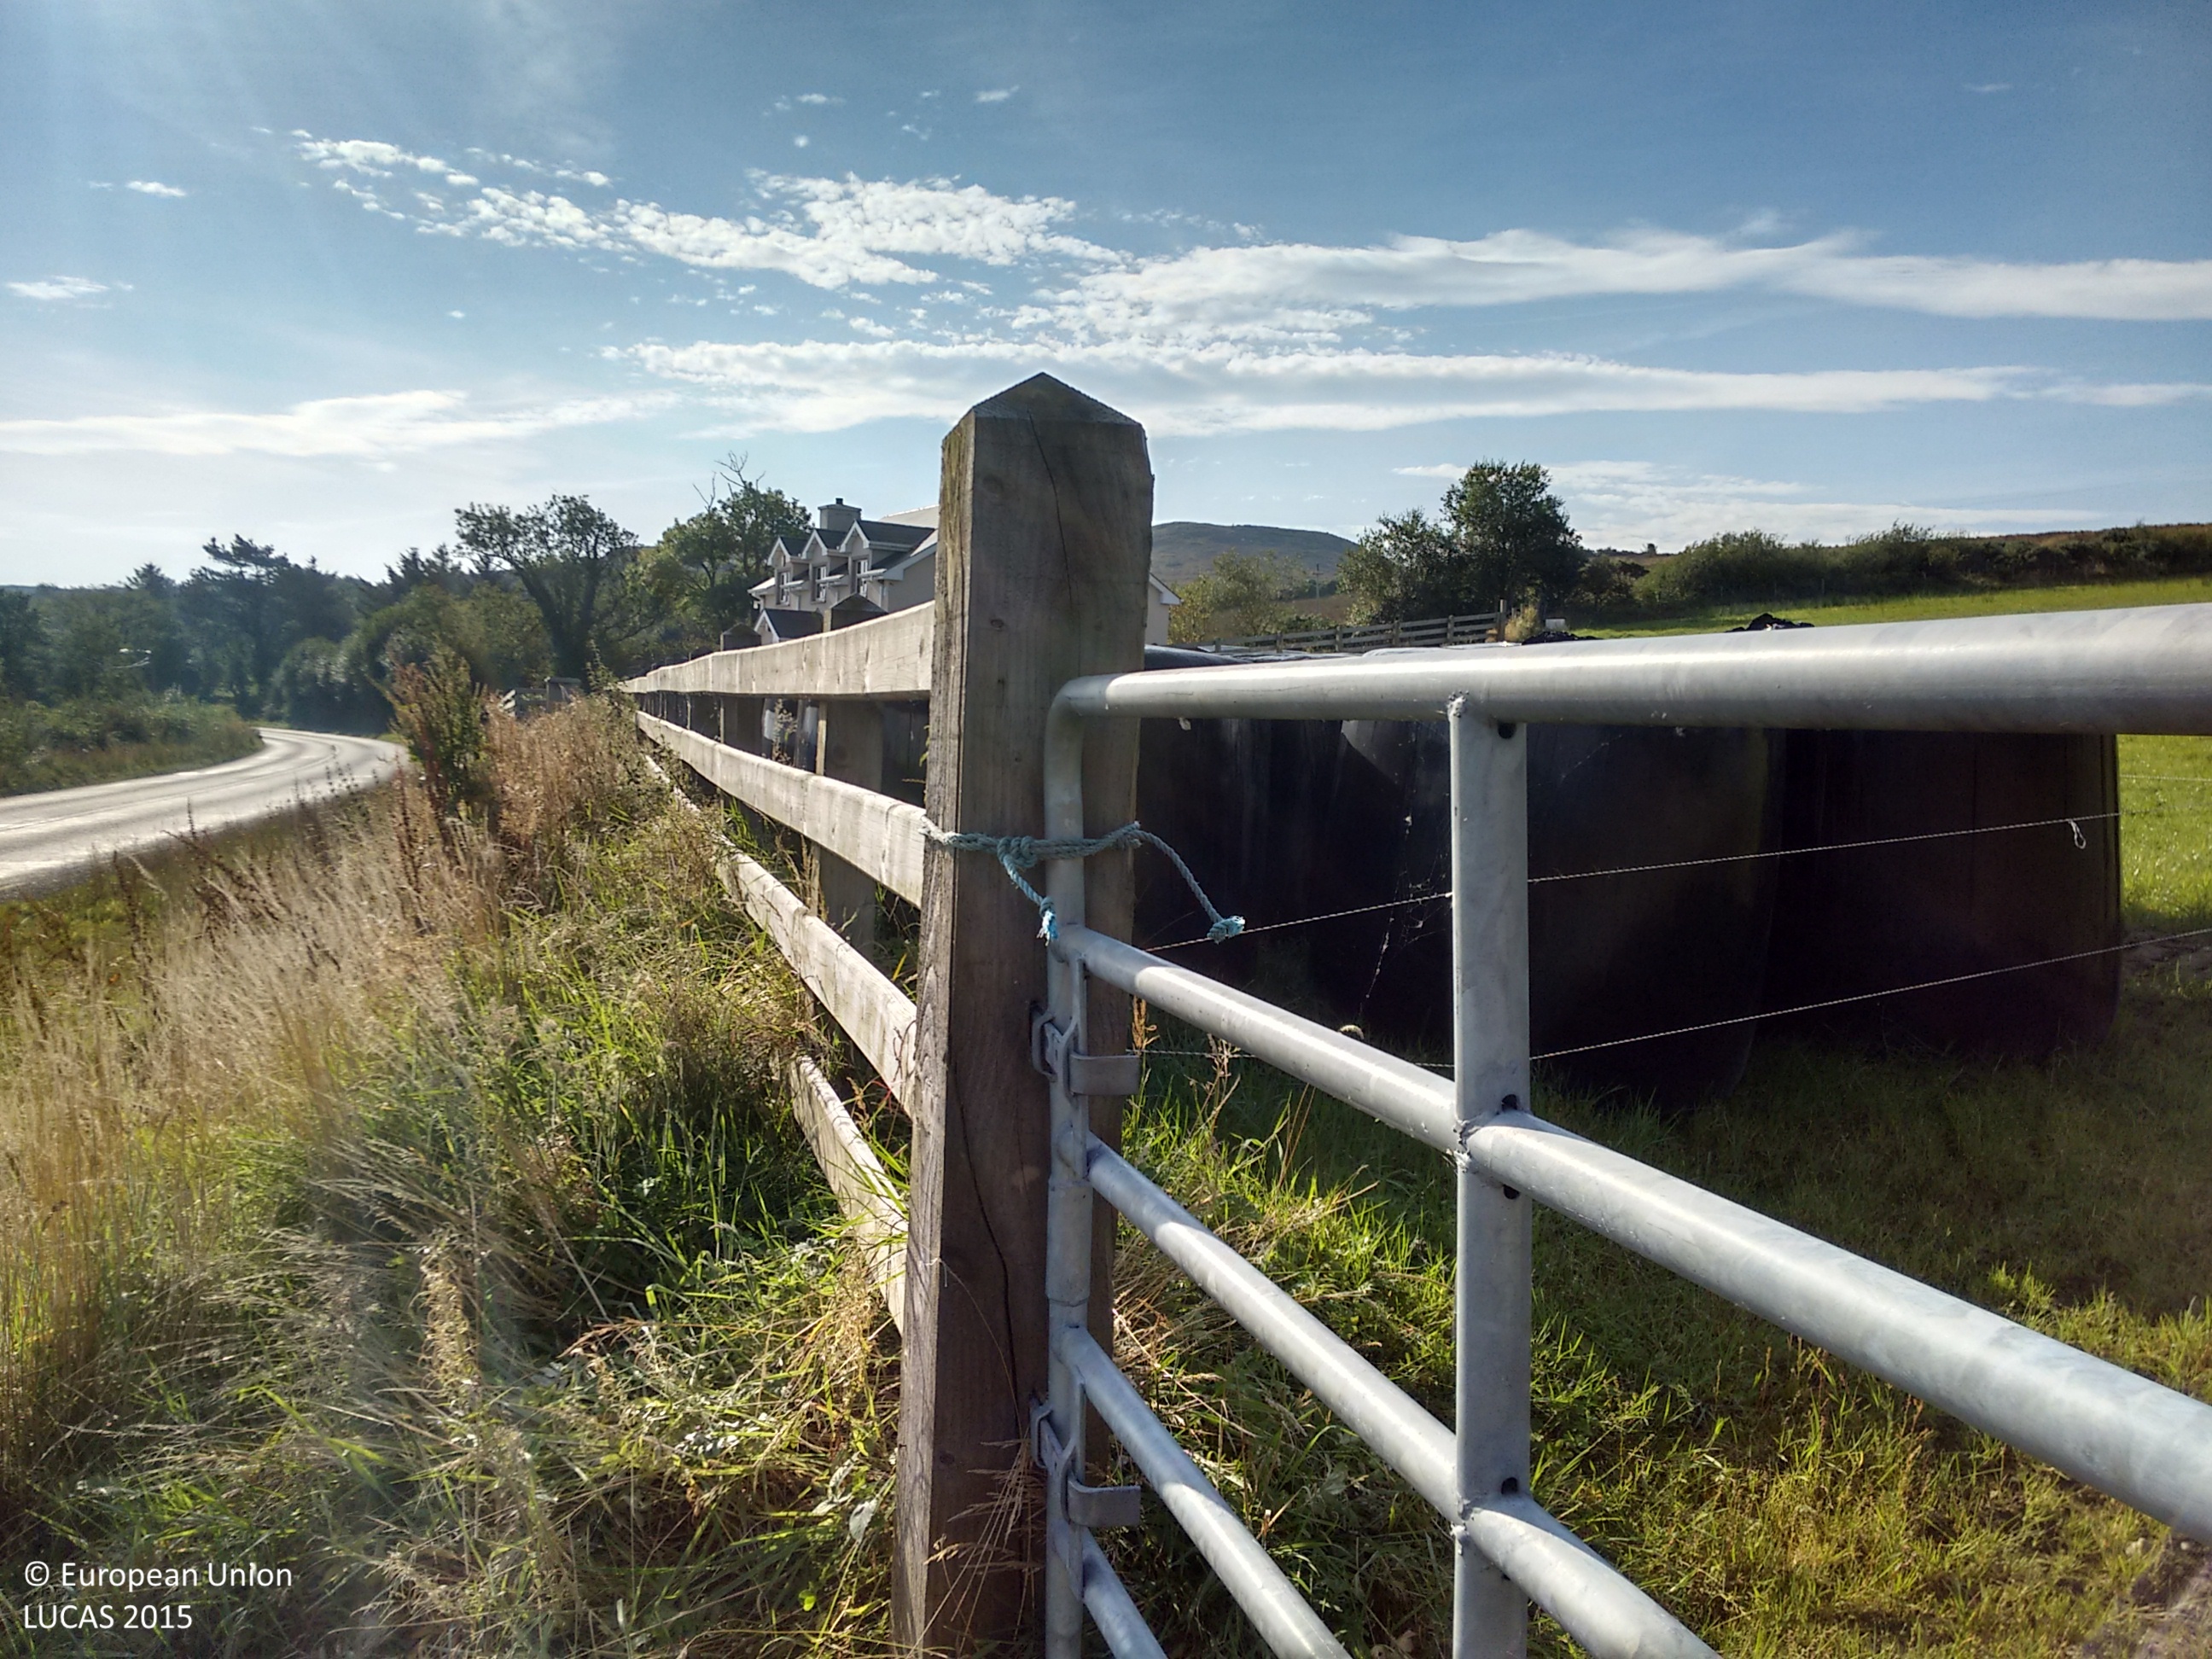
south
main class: Grassland
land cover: Grassland without tree/shrub cover
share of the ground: > 75 %
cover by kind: herbaceous plants 100 %
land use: Agriculture (excluding fallow land and kitchen gardens)
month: September
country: IE
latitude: 55.1598
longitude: -7.7243
